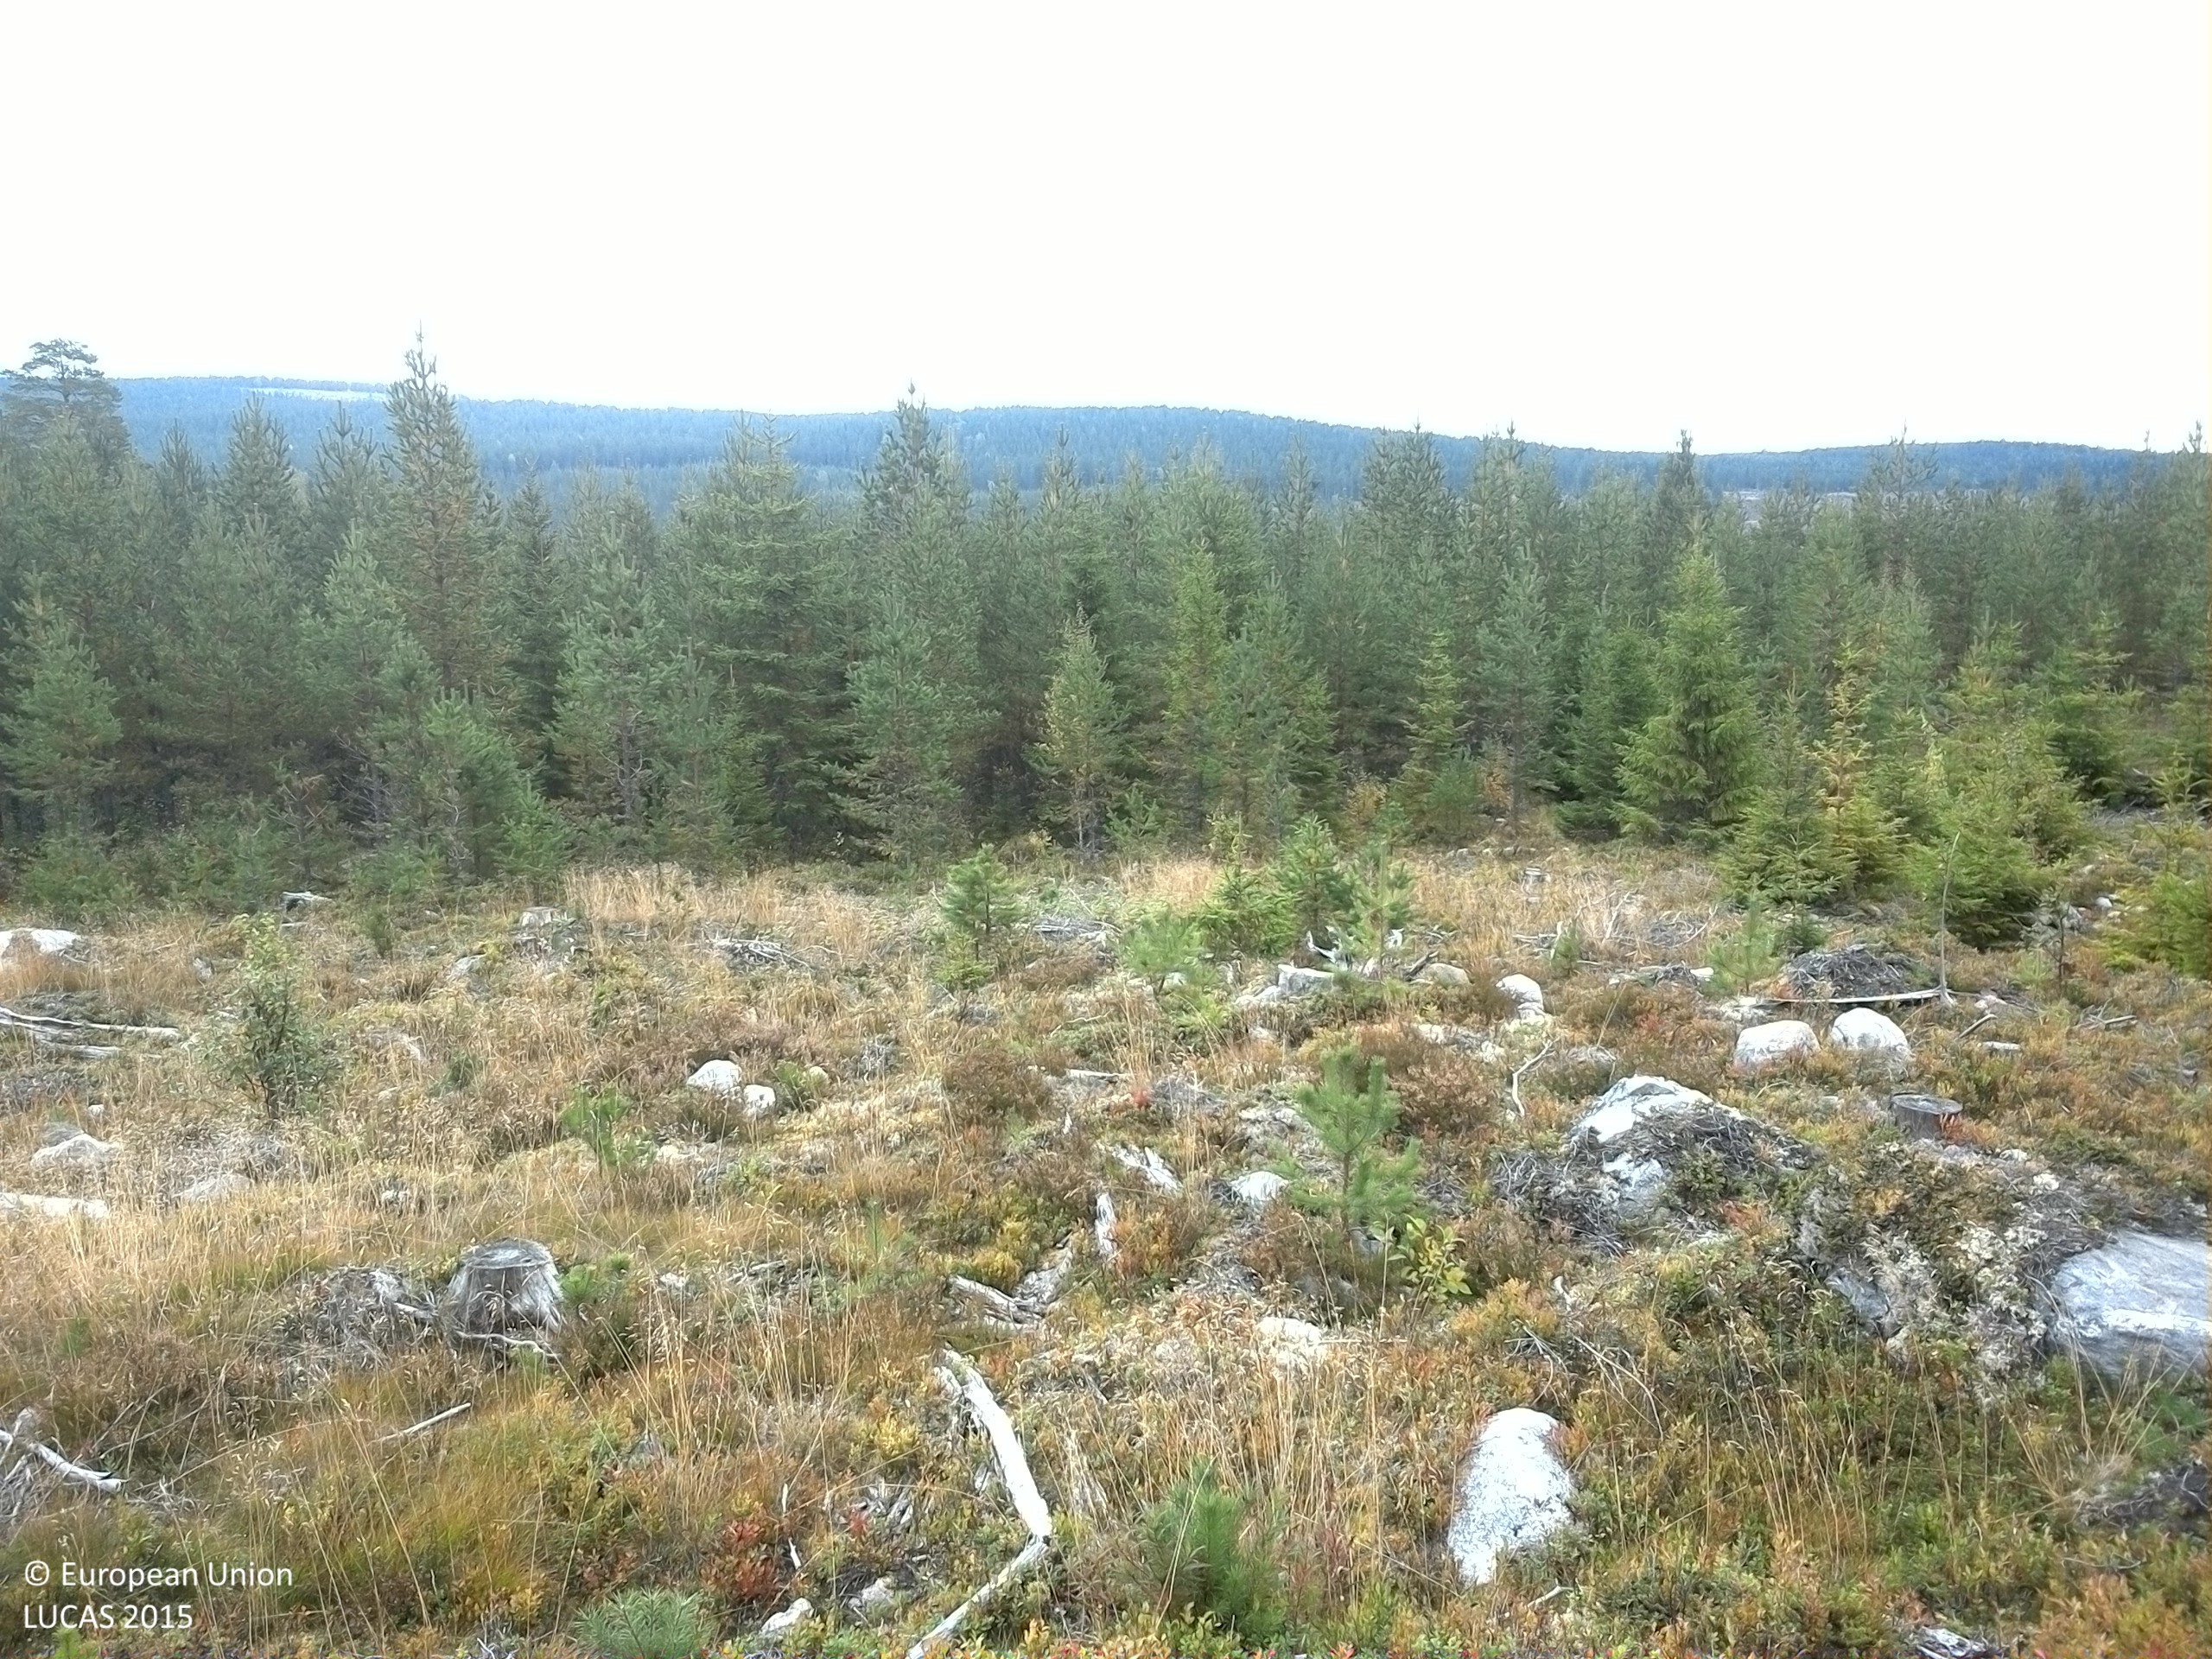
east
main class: Shrubland
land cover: Shrubland with sparse tree cover
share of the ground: > 75 %
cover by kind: shrubs 60 %, consolidated bare surface 20 %, lichens and mosses 15 %, coniferous forest trees 5 %
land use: Forestry
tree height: < 5 m
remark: Clear cut
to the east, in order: Shrubland with sparse tree cover; Other mixed woodland; Pine dominated coniferous woodland
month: September
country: SE
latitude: 61.6675
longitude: 15.3665
